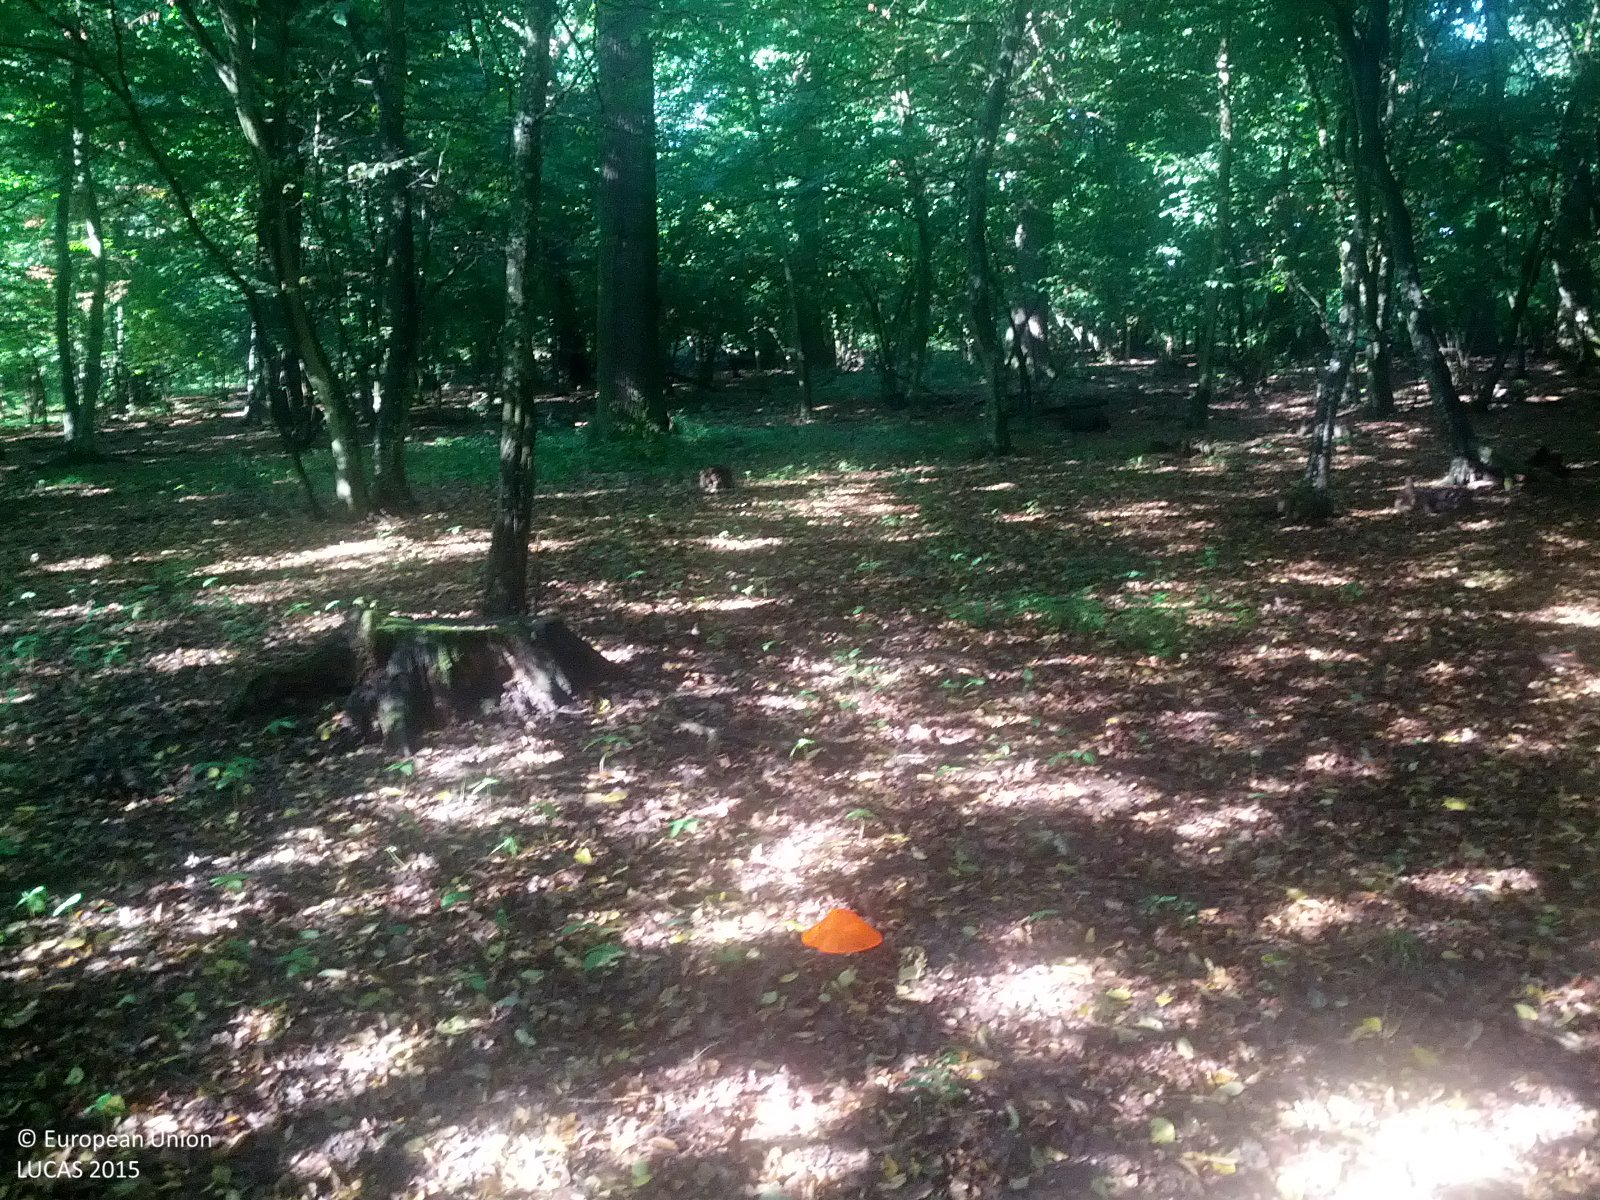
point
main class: Woodland
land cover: Broadleaved woodland
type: beech forest
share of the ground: > 75 %
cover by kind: broadleaved forest trees 100 %
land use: Forestry
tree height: > 5 m
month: July
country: AT
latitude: 48.5858
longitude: 16.2820
